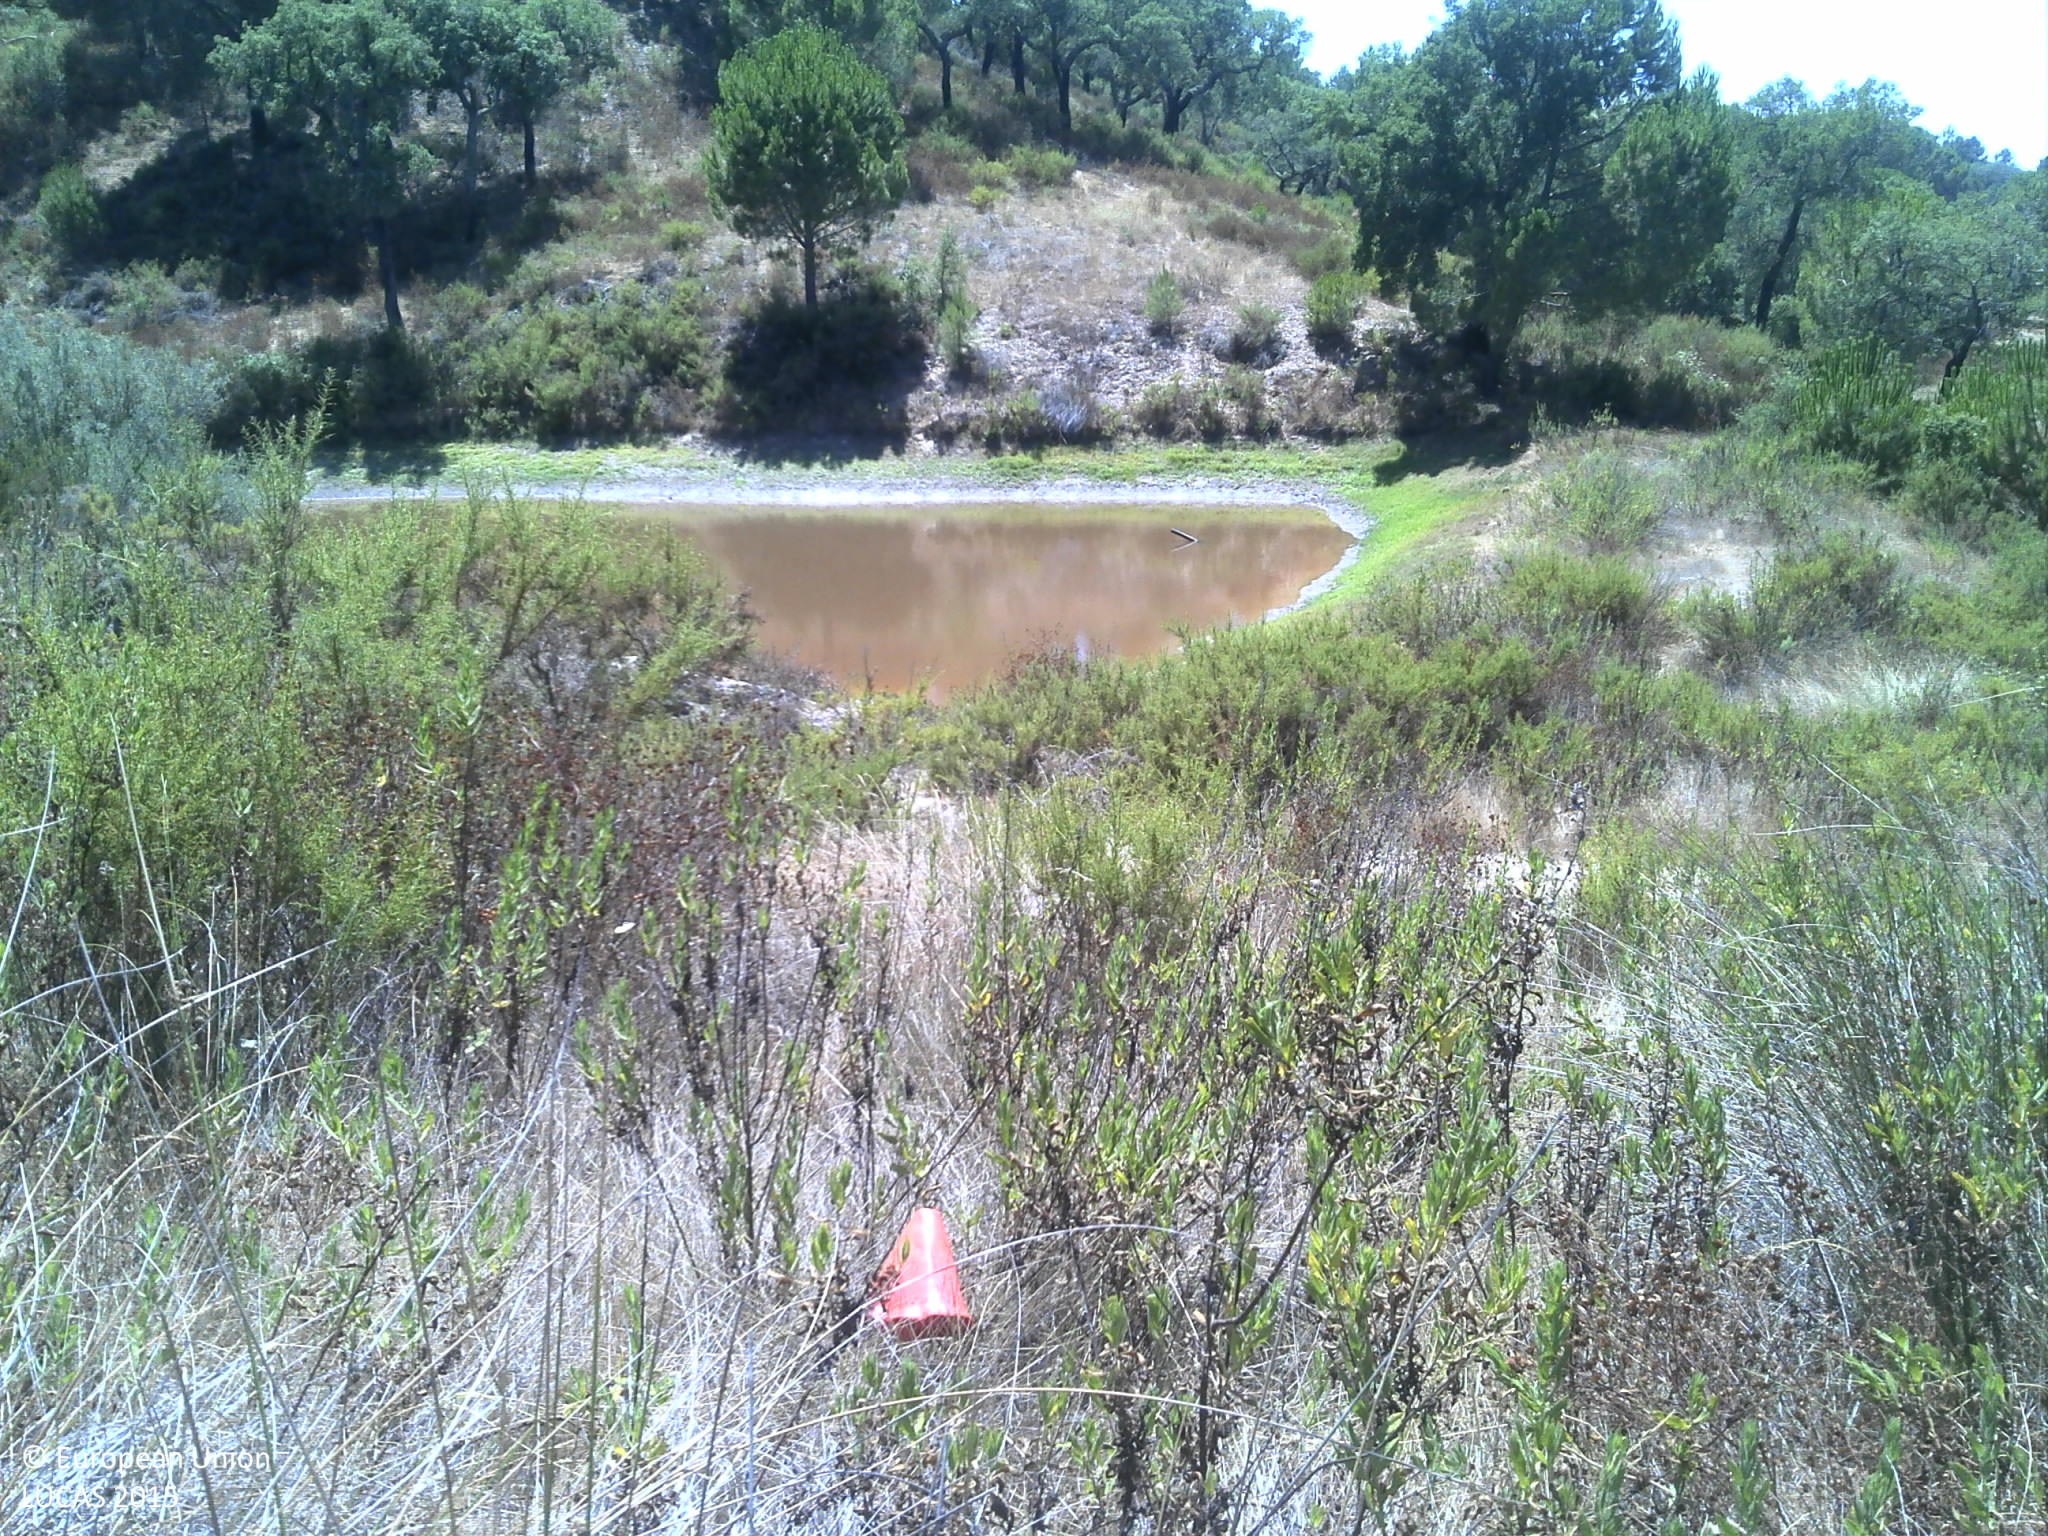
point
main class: Shrubland
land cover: Shrubland without tree cover
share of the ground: 50 - 75 %
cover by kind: shrubs 50 %, unconsolidated bare surface 40 %, herbaceous plants 10 %
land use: Forestry
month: July
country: PT
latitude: 39.0247
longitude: -8.2254
